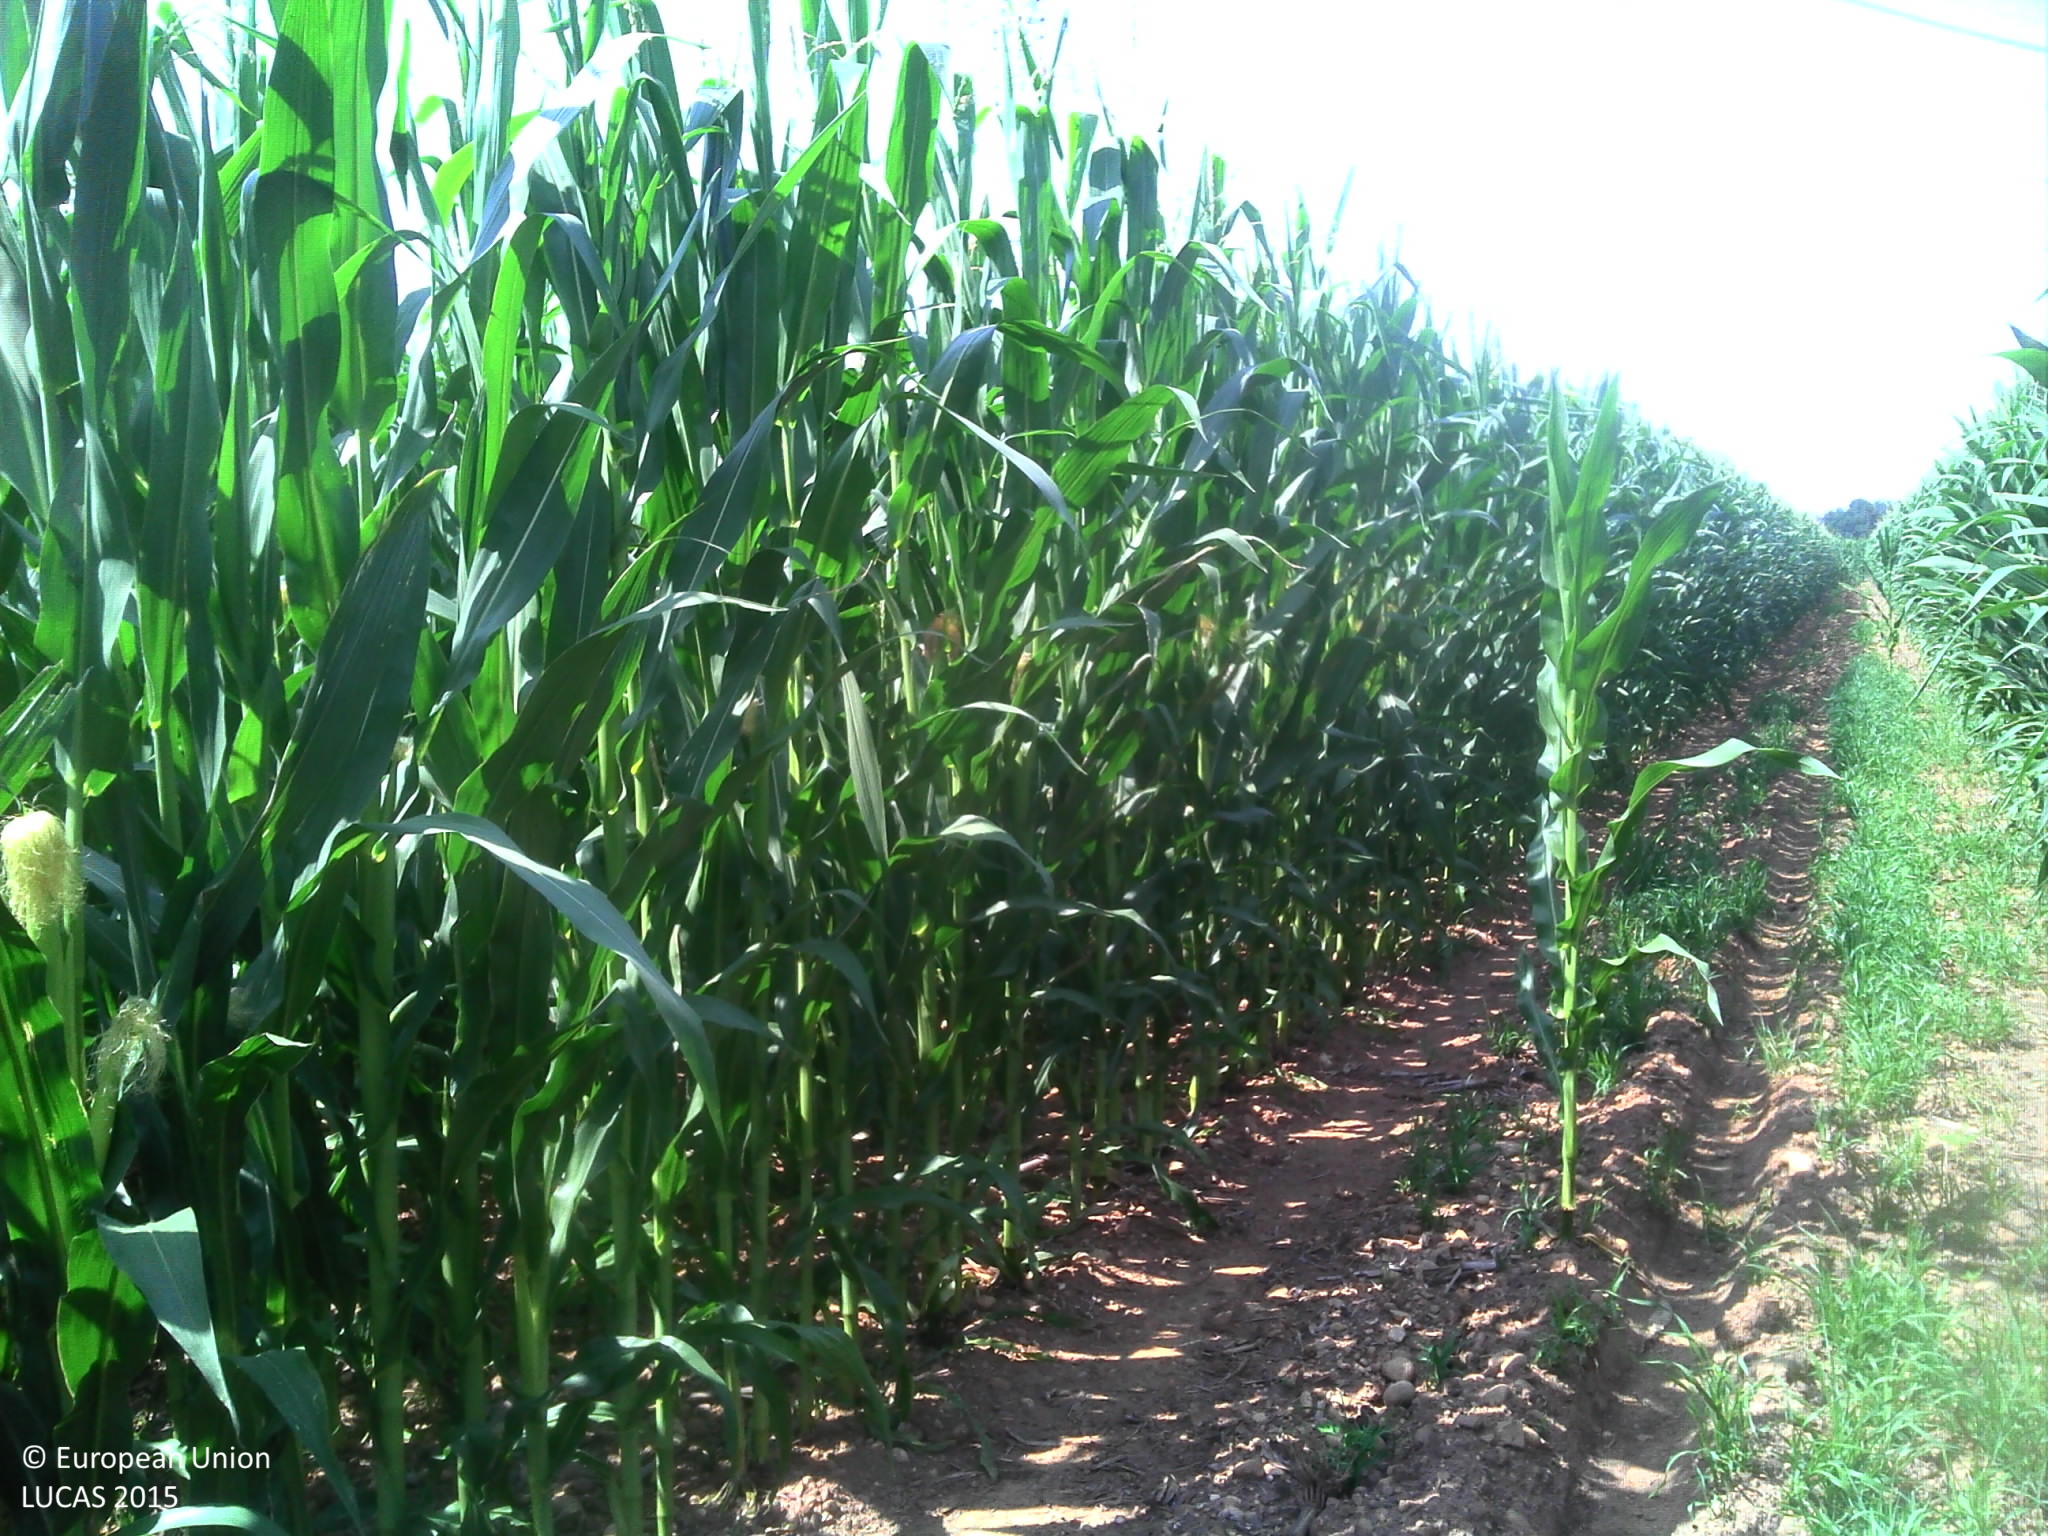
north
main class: Cropland
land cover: Maize
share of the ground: > 75 %
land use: Agriculture (excluding fallow land and kitchen gardens)
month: July
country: FR
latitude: 45.7195
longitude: 5.1861
